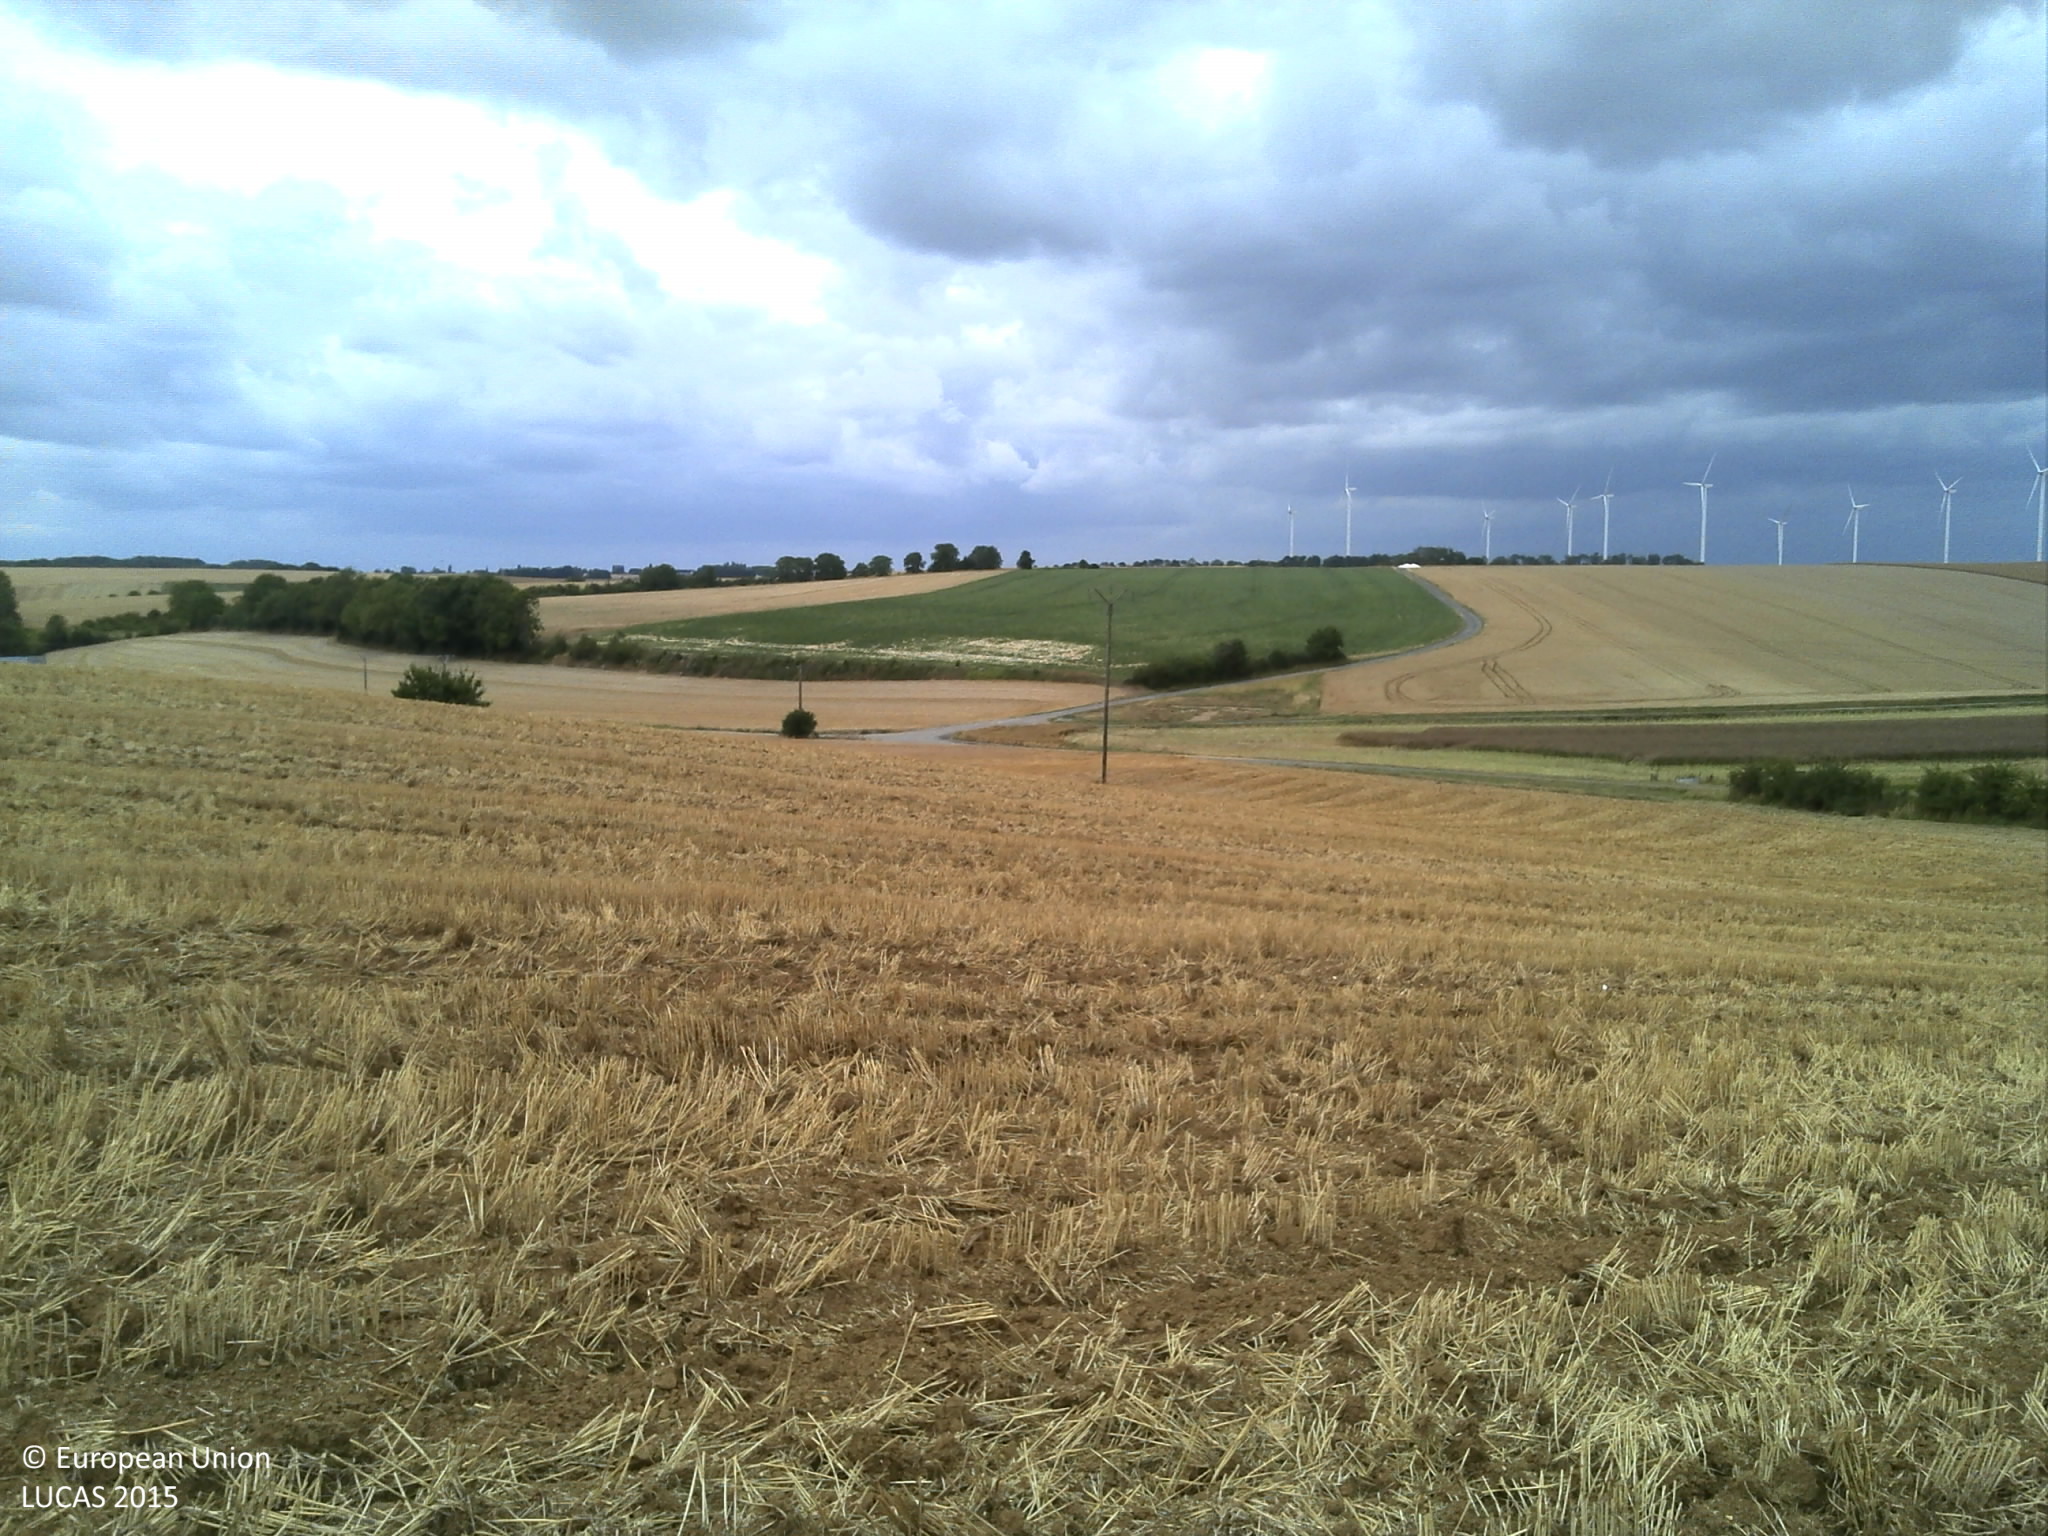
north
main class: Cropland
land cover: Common wheat
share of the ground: 50 - 75 %
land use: Agriculture (excluding fallow land and kitchen gardens)
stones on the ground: < 10 %
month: July
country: FR
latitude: 49.6174
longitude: 4.1125
